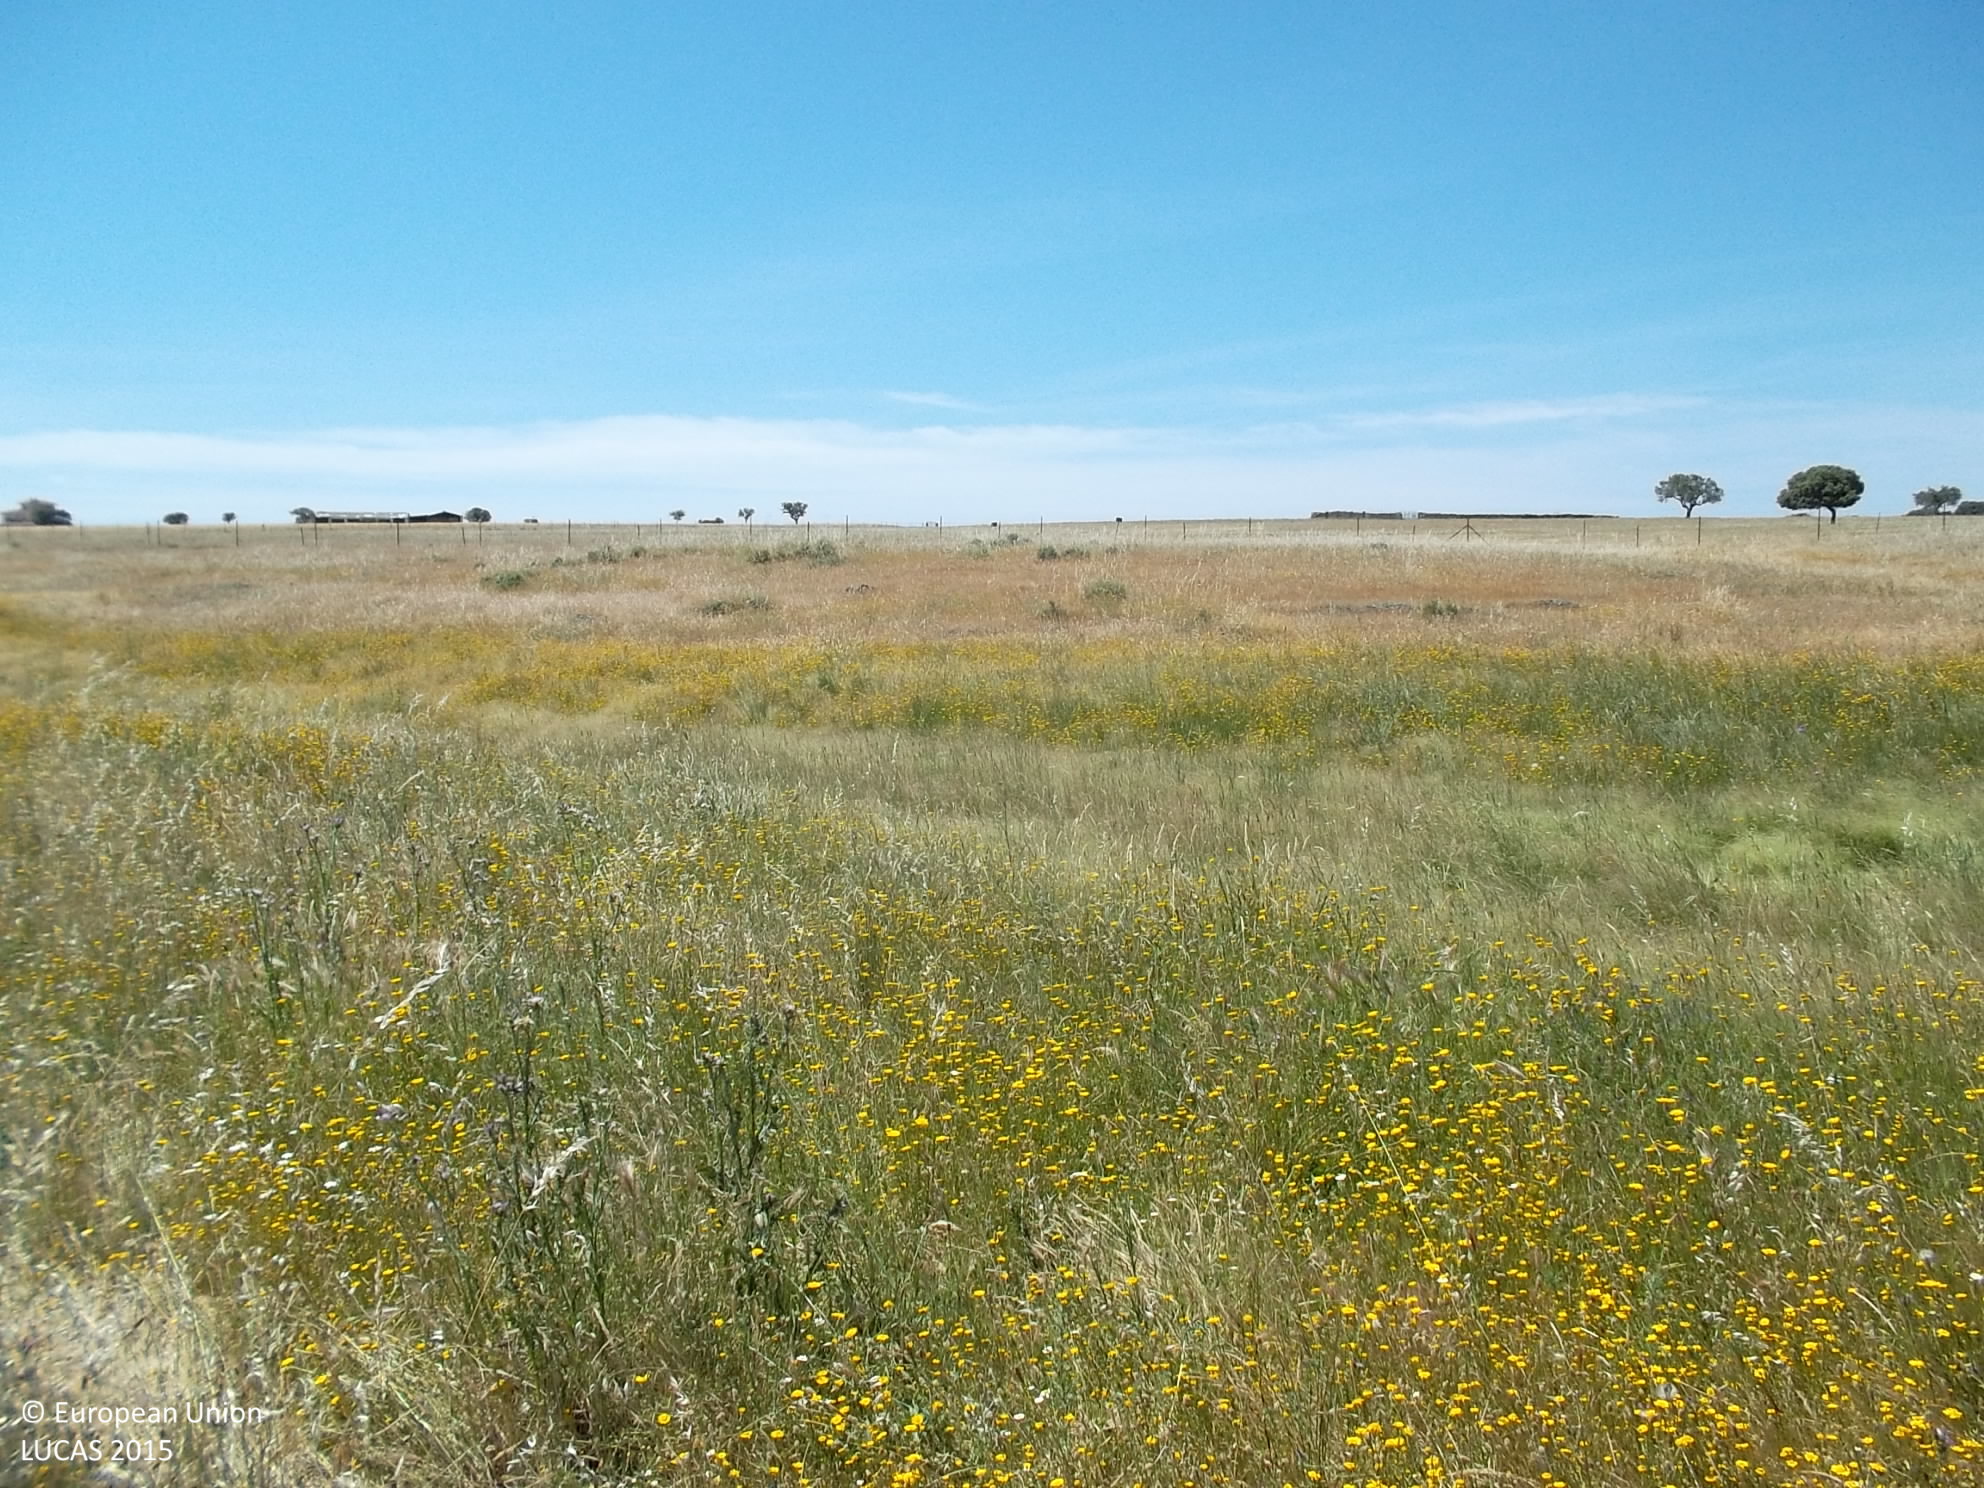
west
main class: Grassland
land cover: Grassland with sparse tree/shrub cover
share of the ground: > 75 %
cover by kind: herbaceous plants 95 %, broadleaved forest trees 5 %
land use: Agriculture (excluding fallow land and kitchen gardens)
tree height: > 5 m
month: May
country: ES
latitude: 38.8621
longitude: -4.4423
